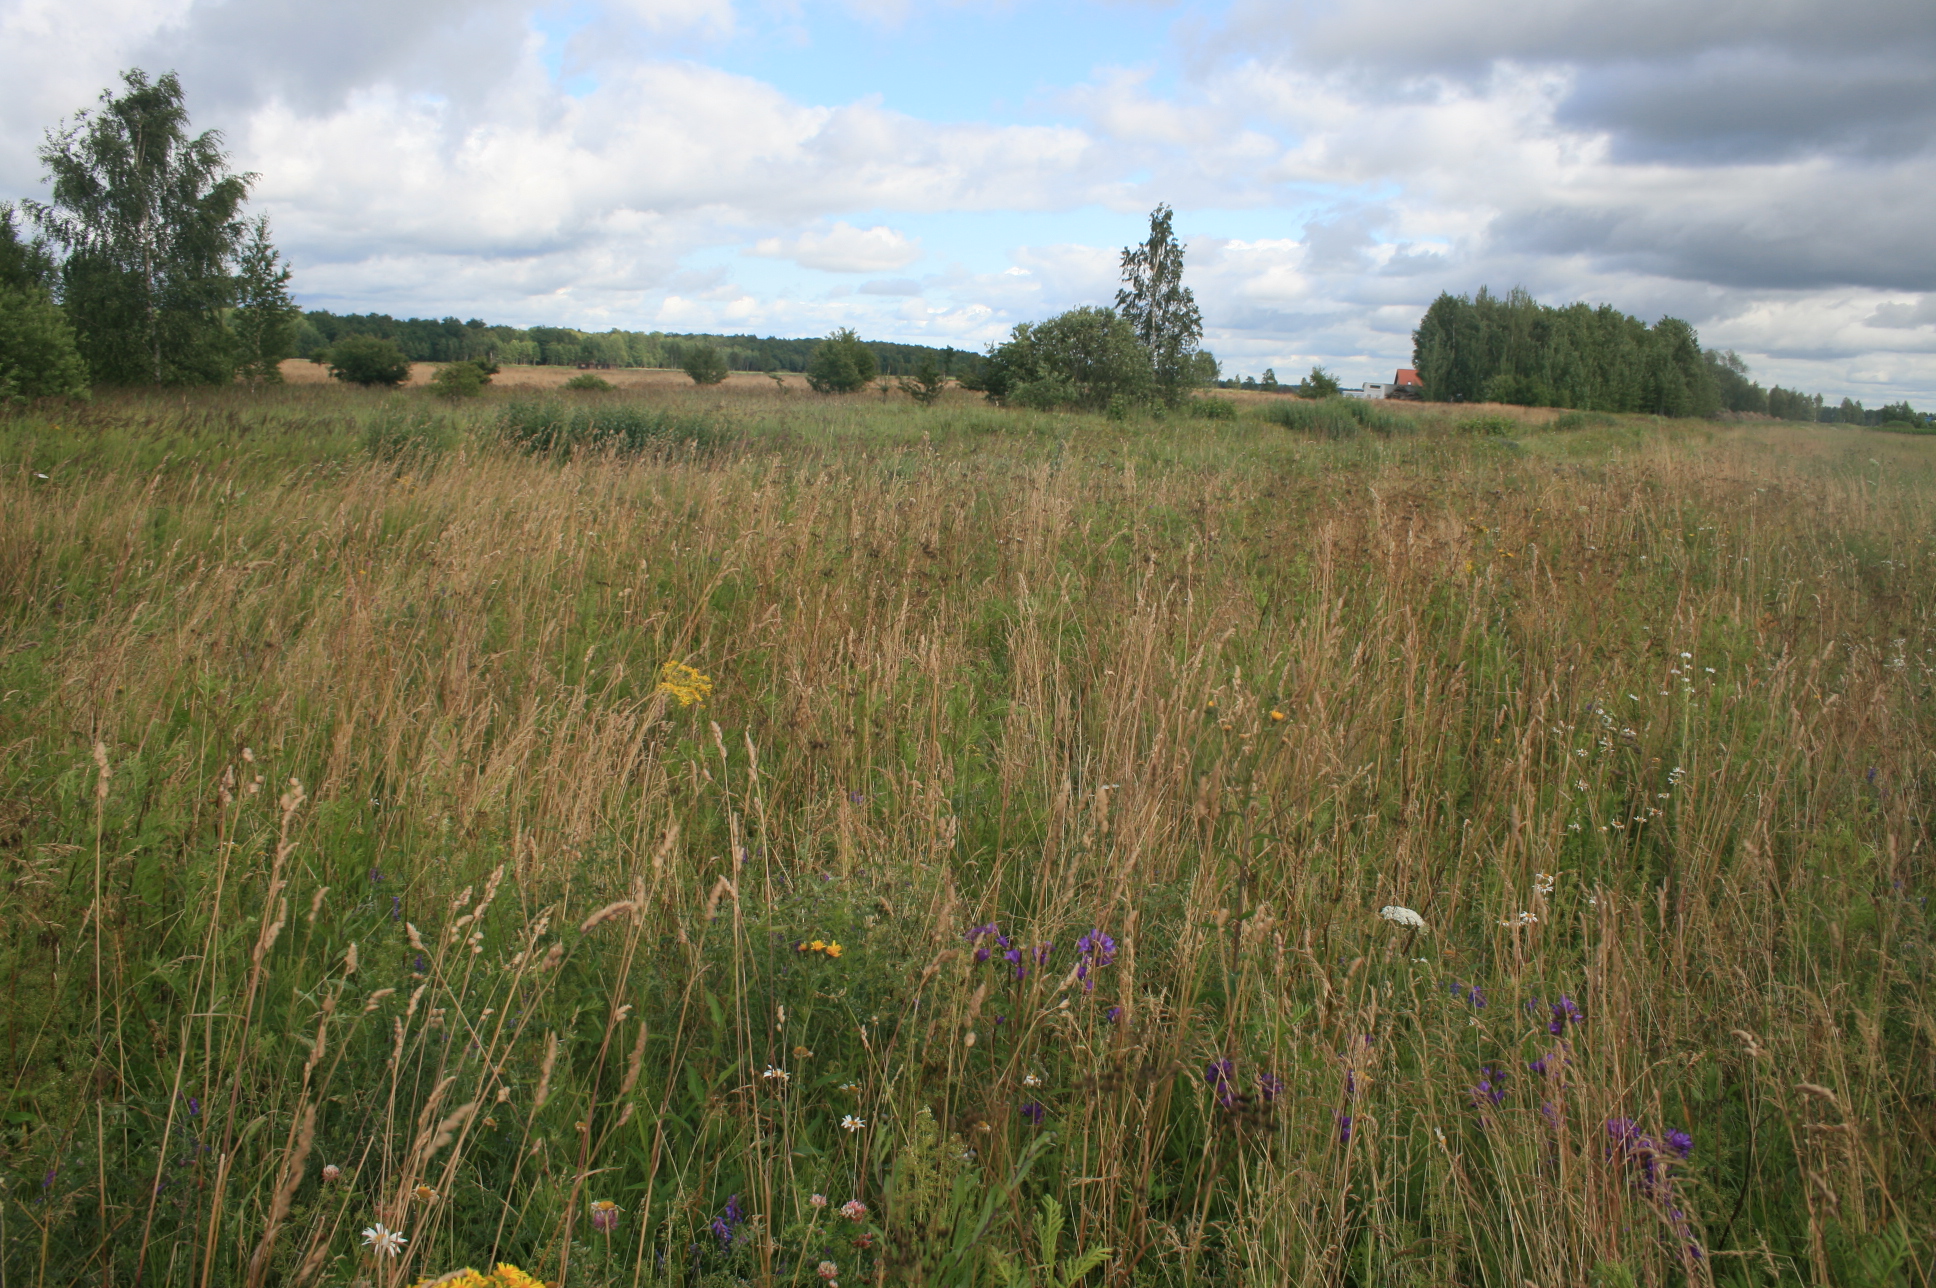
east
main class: Grassland
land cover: Grassland without tree/shrub cover
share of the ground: > 75 %
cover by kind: herbaceous plants 100 %
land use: Agriculture (excluding fallow land and kitchen gardens)
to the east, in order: Grassland without tree/shrub cover; Ditches and canals; Grassland without tree/shrub cover; Tracks; Grass margins; Broadleaved woodland; Grassland with sparse tree/shrub cover; Grassland without tree/shrub cover
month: July
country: LT
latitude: 55.7672
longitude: 21.2143
